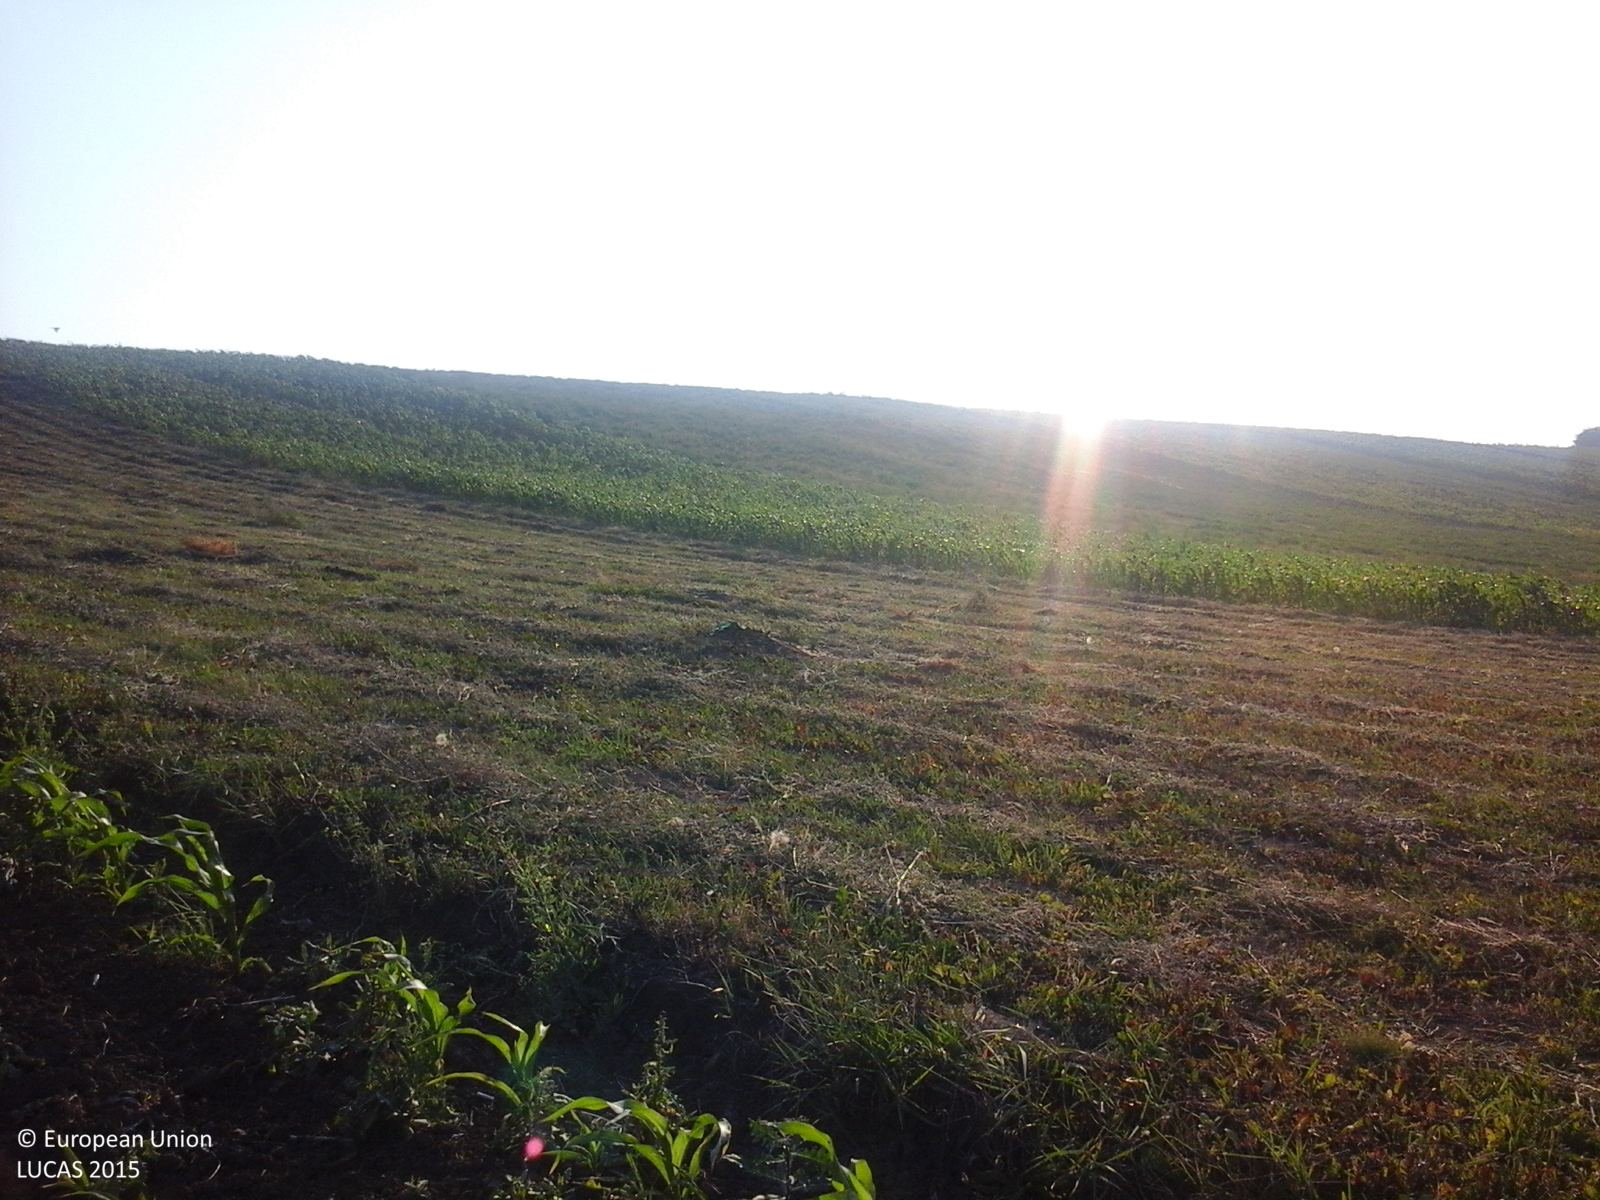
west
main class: Cropland
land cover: Maize
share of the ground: 10 - 25 %
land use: Agriculture (excluding fallow land and kitchen gardens)
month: June
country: RO
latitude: 46.6990
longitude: 27.3848
